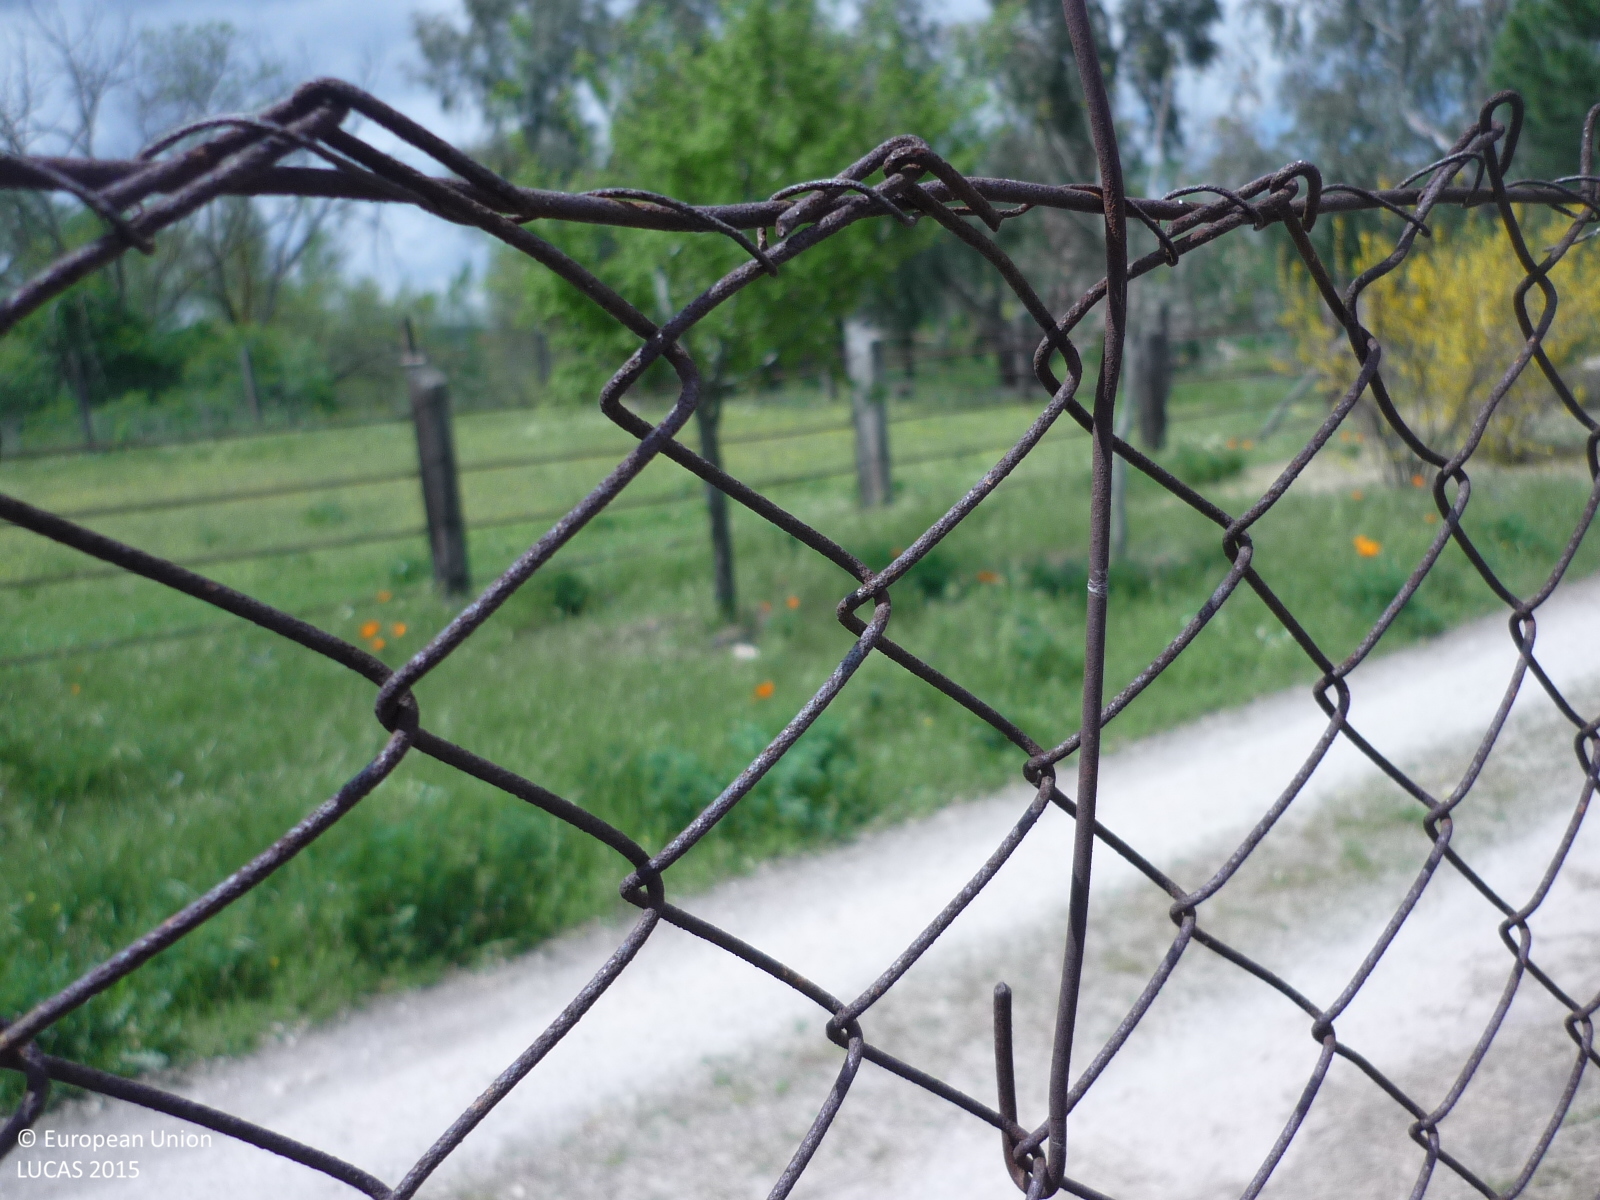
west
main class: Grassland
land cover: Grassland without tree/shrub cover
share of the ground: > 75 %
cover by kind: herbaceous plants 90 %, consolidated bare surface 5 %, unconsolidated bare surface 5 %
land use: Sport
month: April
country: ES
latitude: 40.6195
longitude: -3.5732
